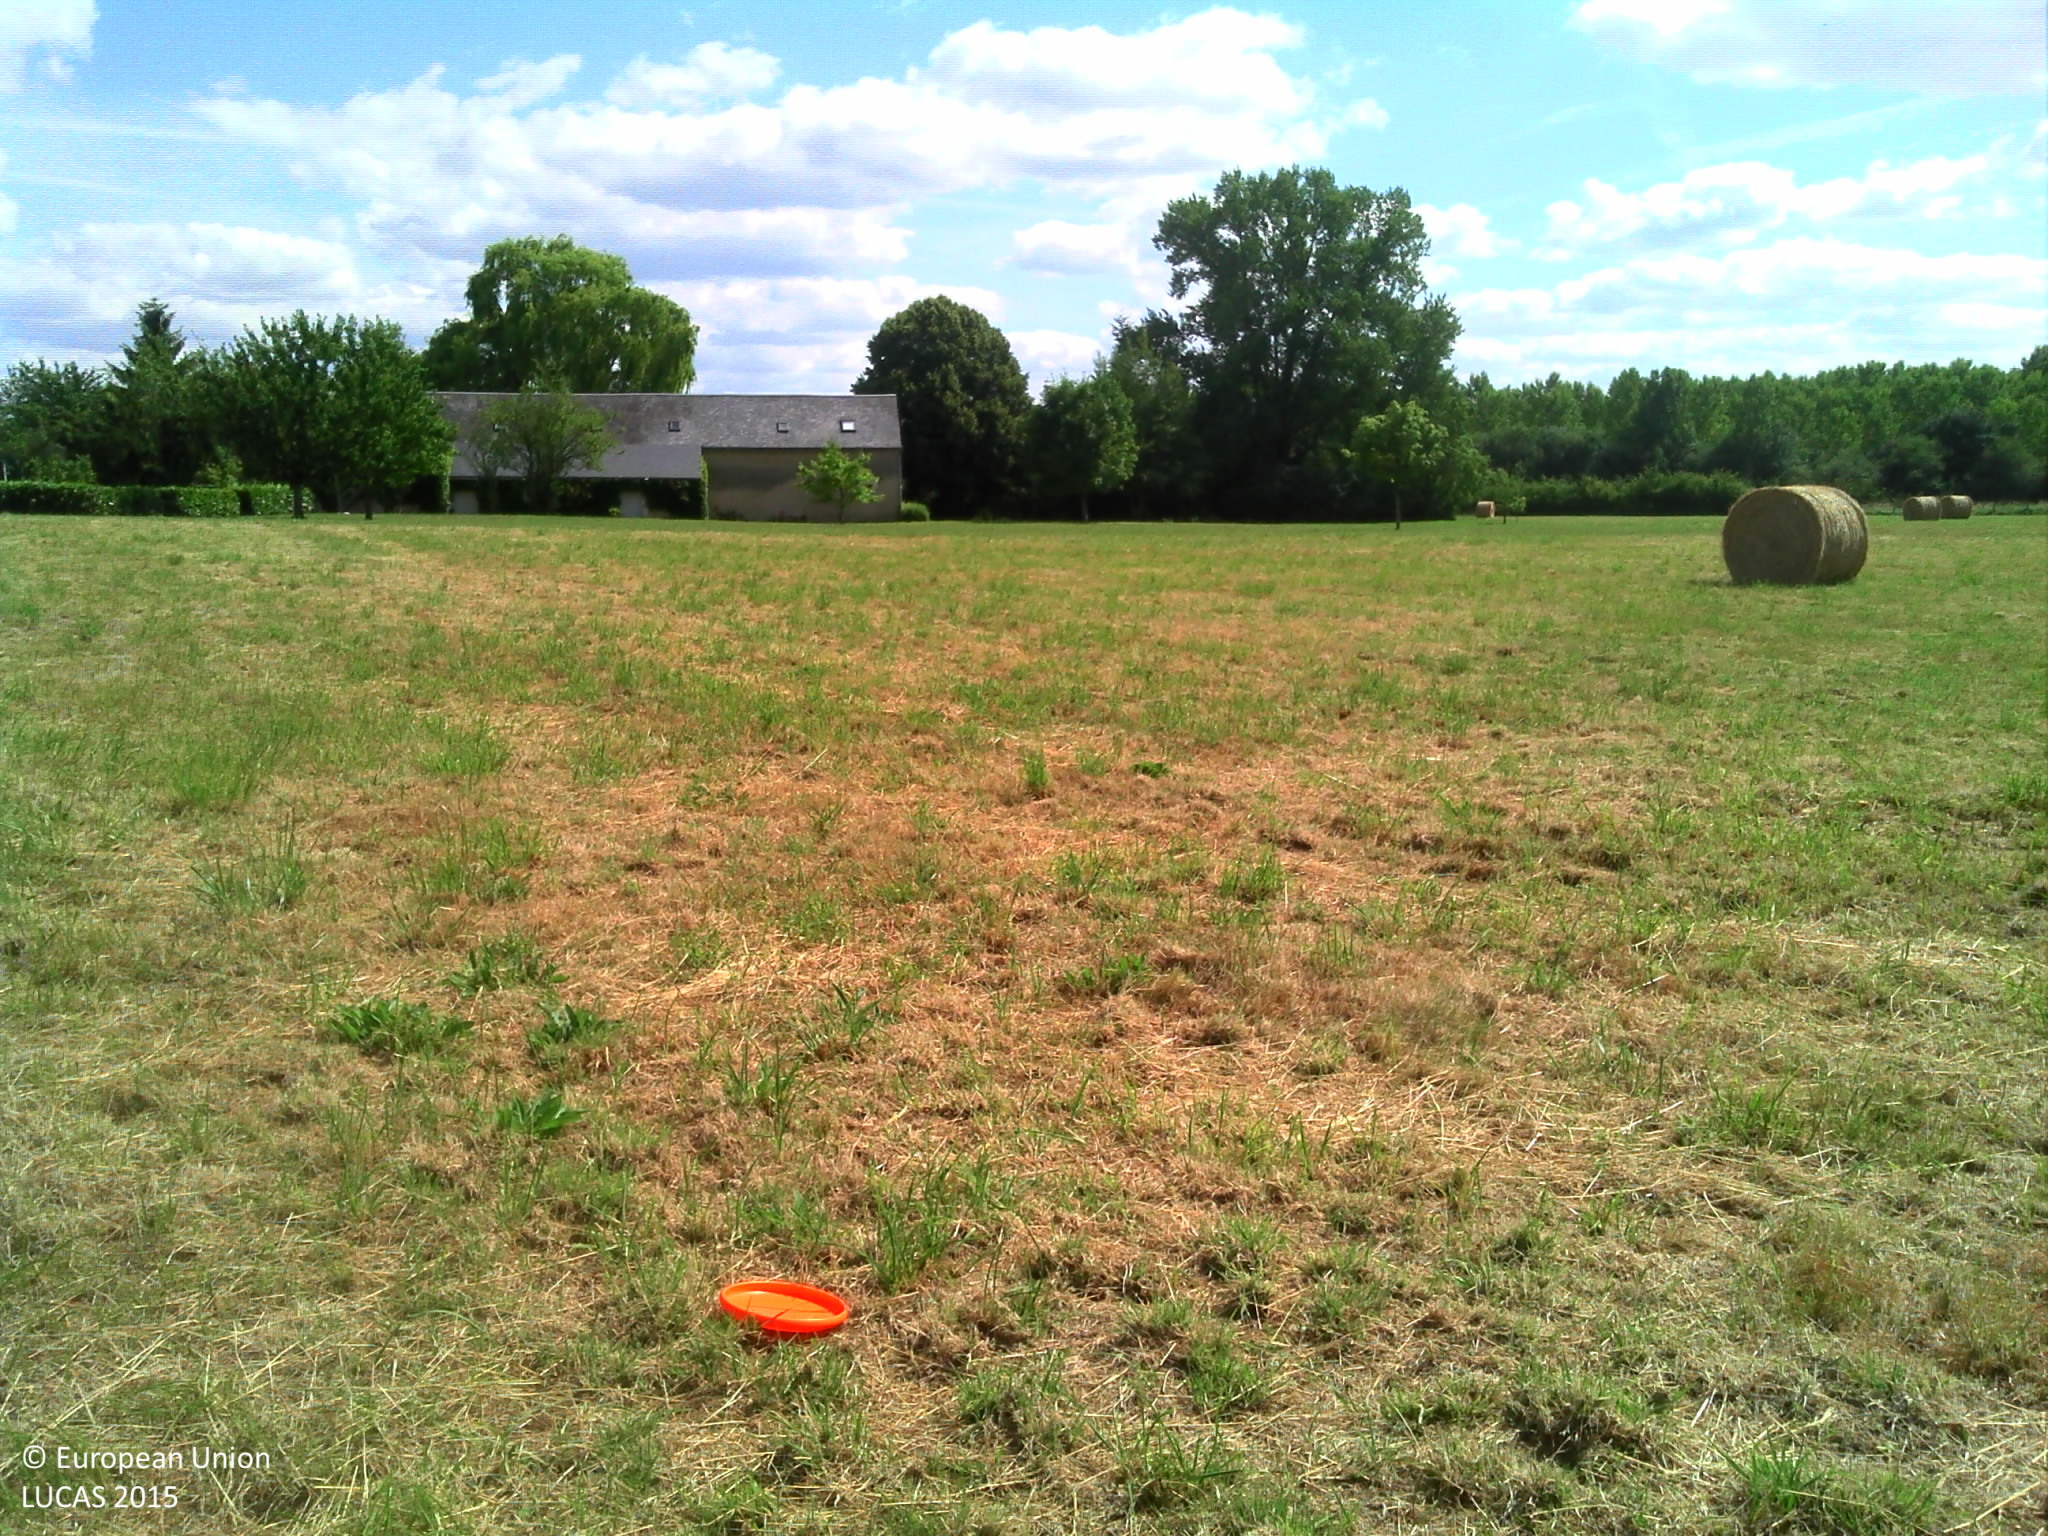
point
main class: Grassland
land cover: Grassland without tree/shrub cover
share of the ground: > 75 %
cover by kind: herbaceous plants 100 %
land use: Agriculture (excluding fallow land and kitchen gardens)
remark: Harvested field
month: June
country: FR
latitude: 47.4869
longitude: 0.3016
